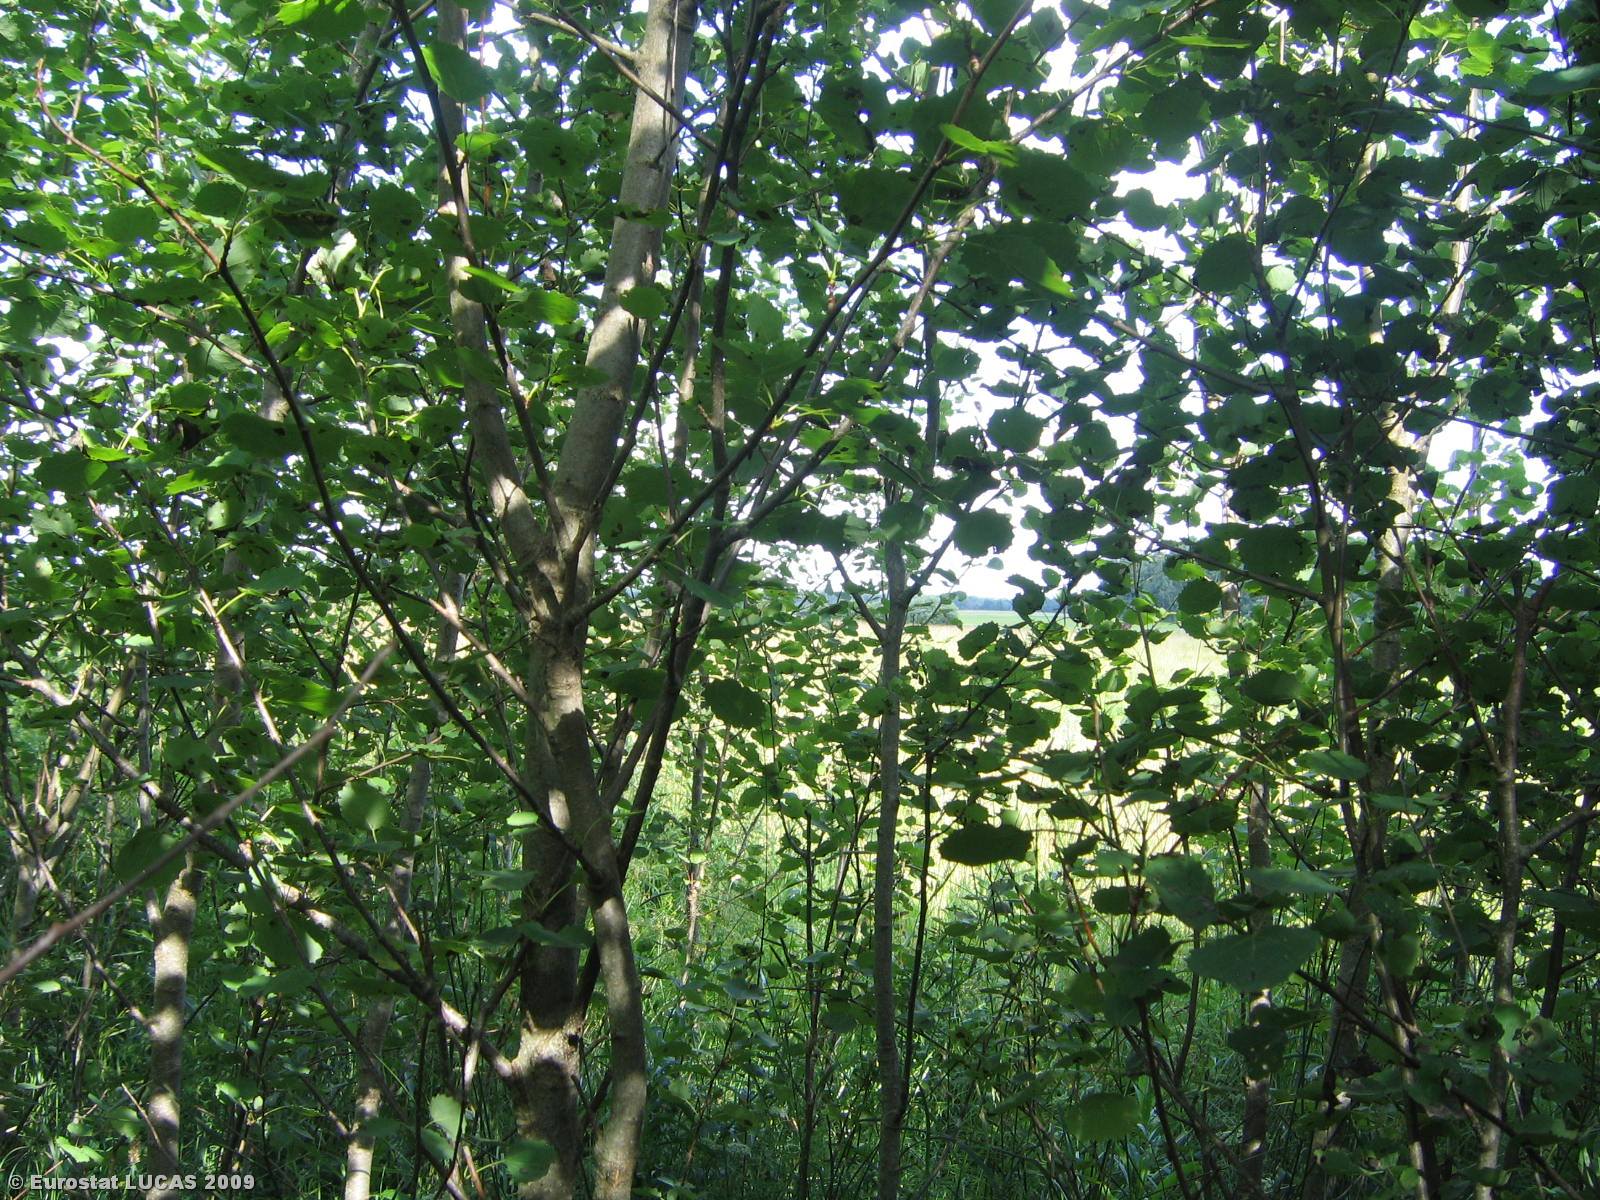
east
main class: Woodland
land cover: Broadleaved woodland
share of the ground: > 75 %
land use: Agriculture (excluding fallow land and kitchen gardens)
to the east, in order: Broadleaved woodland; Grassland without tree/shrub cover; Abandoned hedges; Grassland without tree/shrub cover
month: July
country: LT
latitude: 55.4912
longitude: 22.7749
